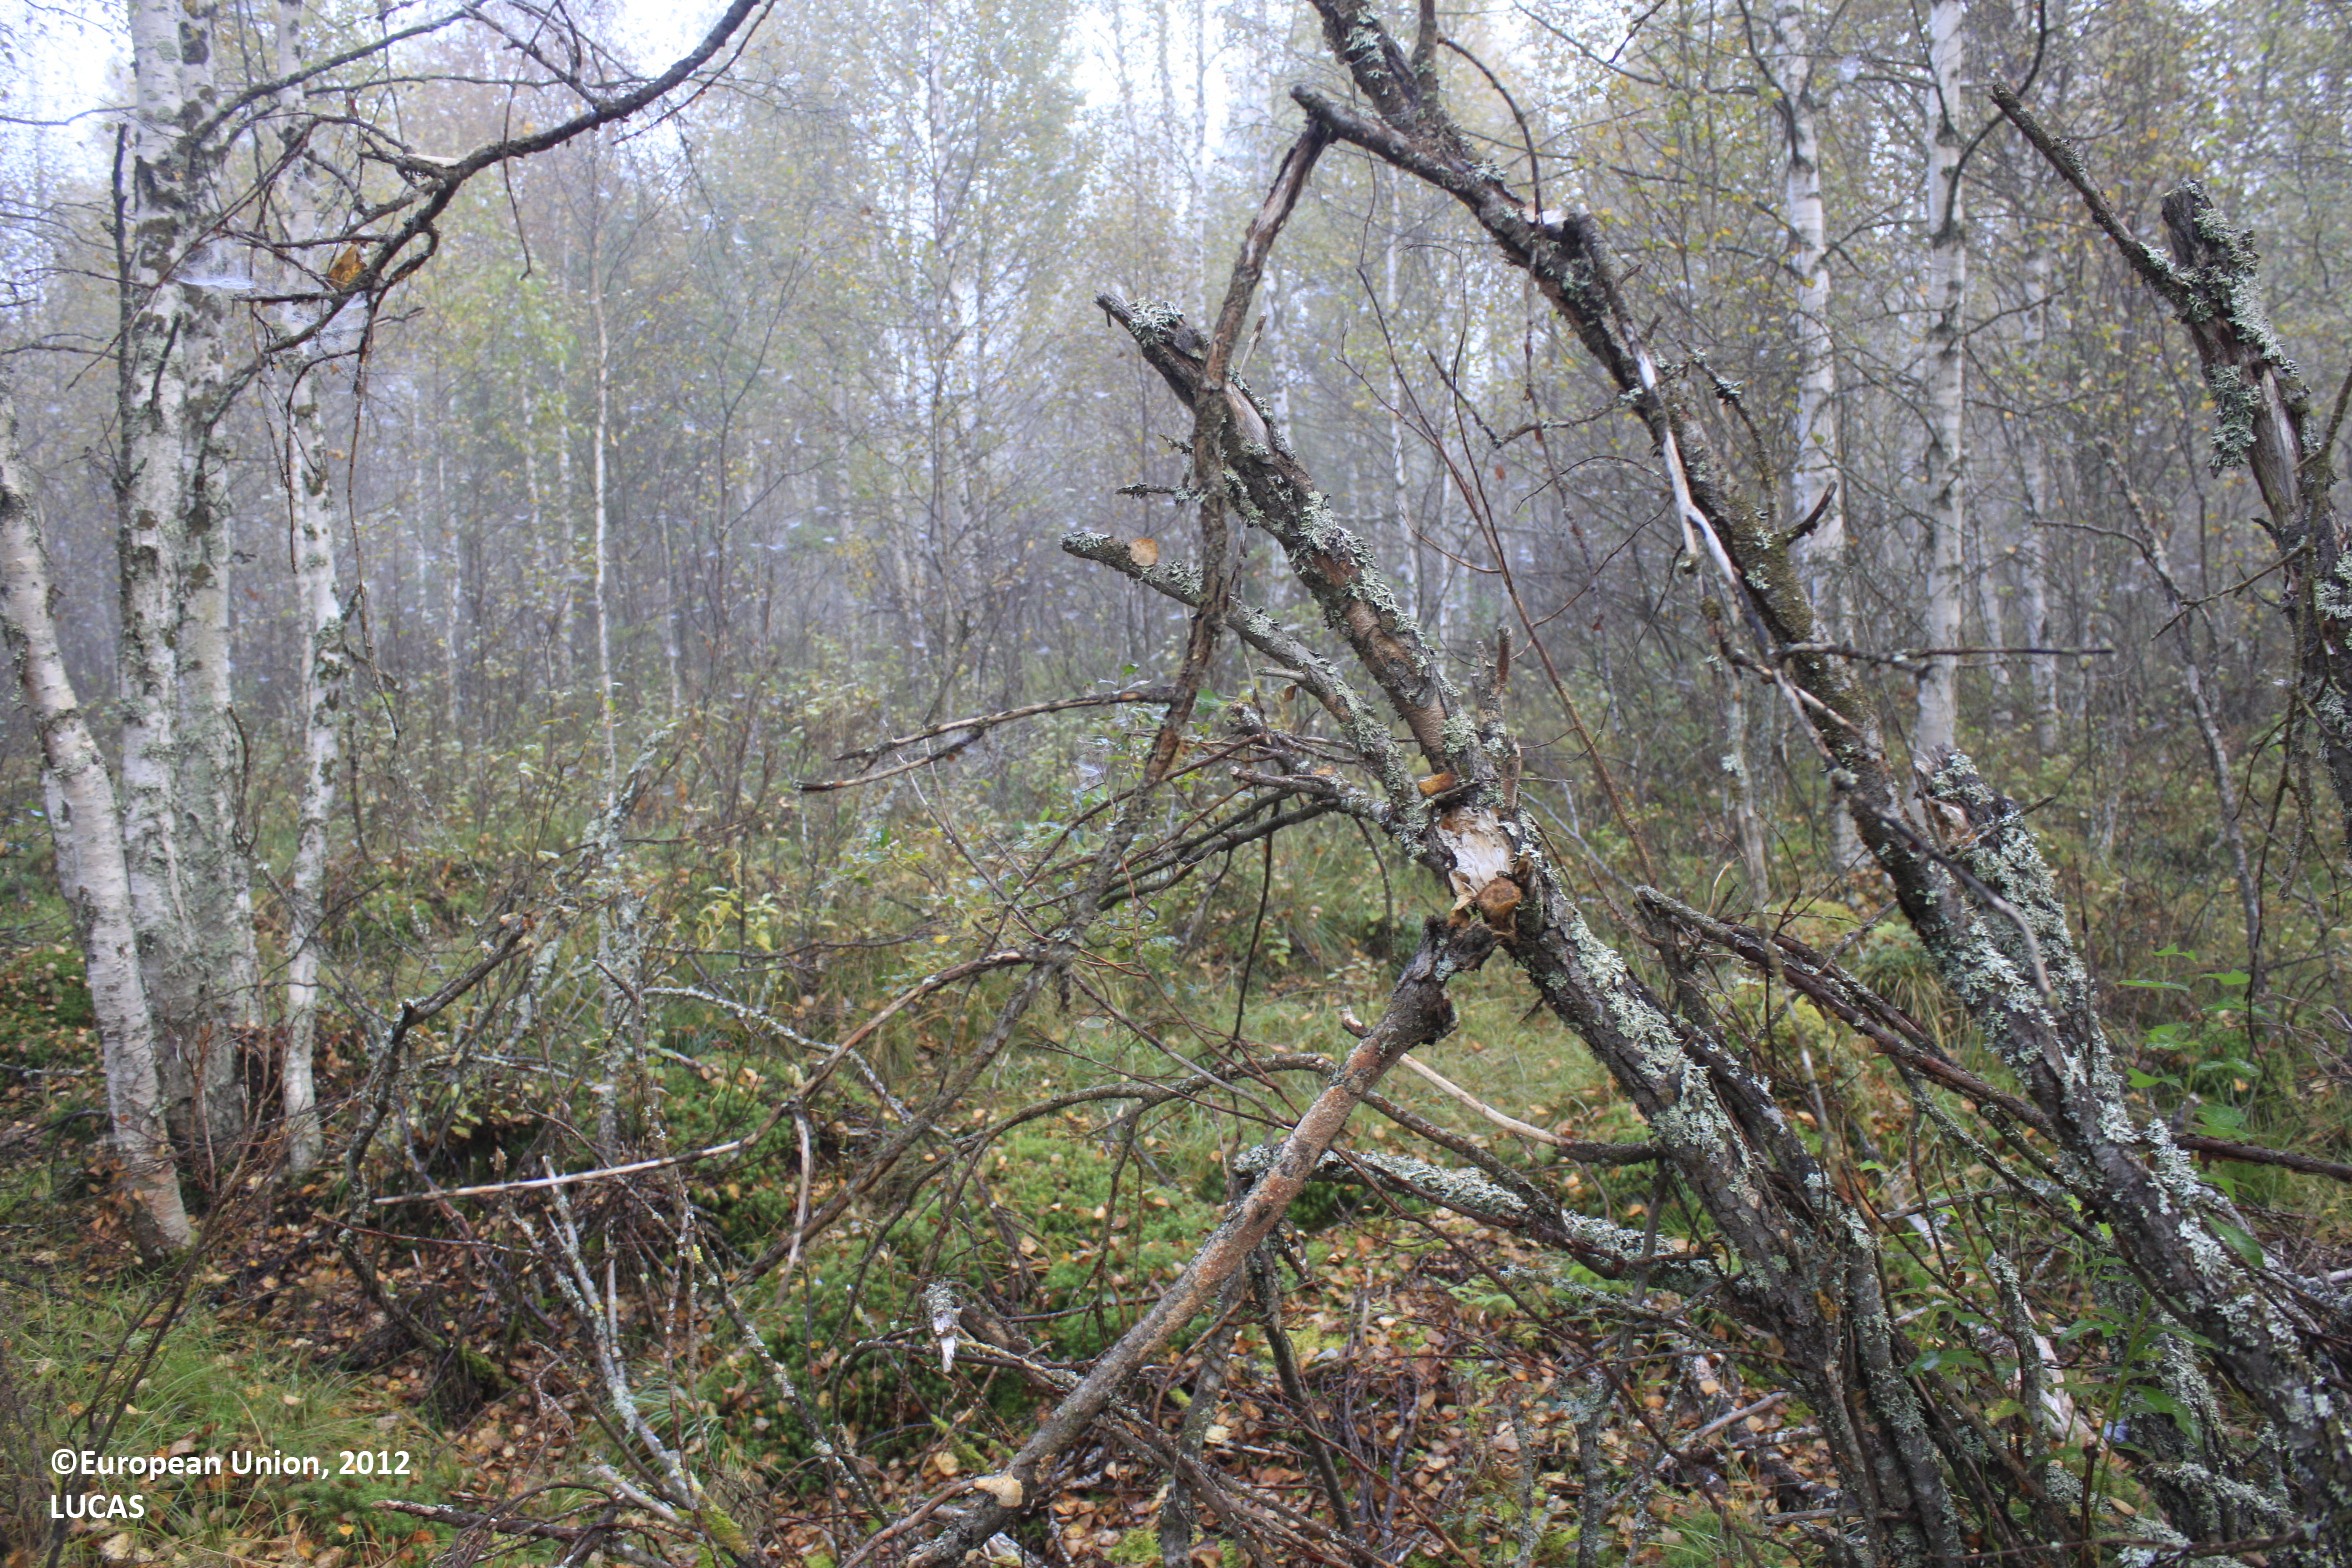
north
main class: Woodland
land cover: Broadleaved woodland
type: non-riverine alder, birch or aspen forest
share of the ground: 50 - 75 %
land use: Forestry
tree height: > 5 m
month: September
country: FI
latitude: 65.1924
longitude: 26.8837
